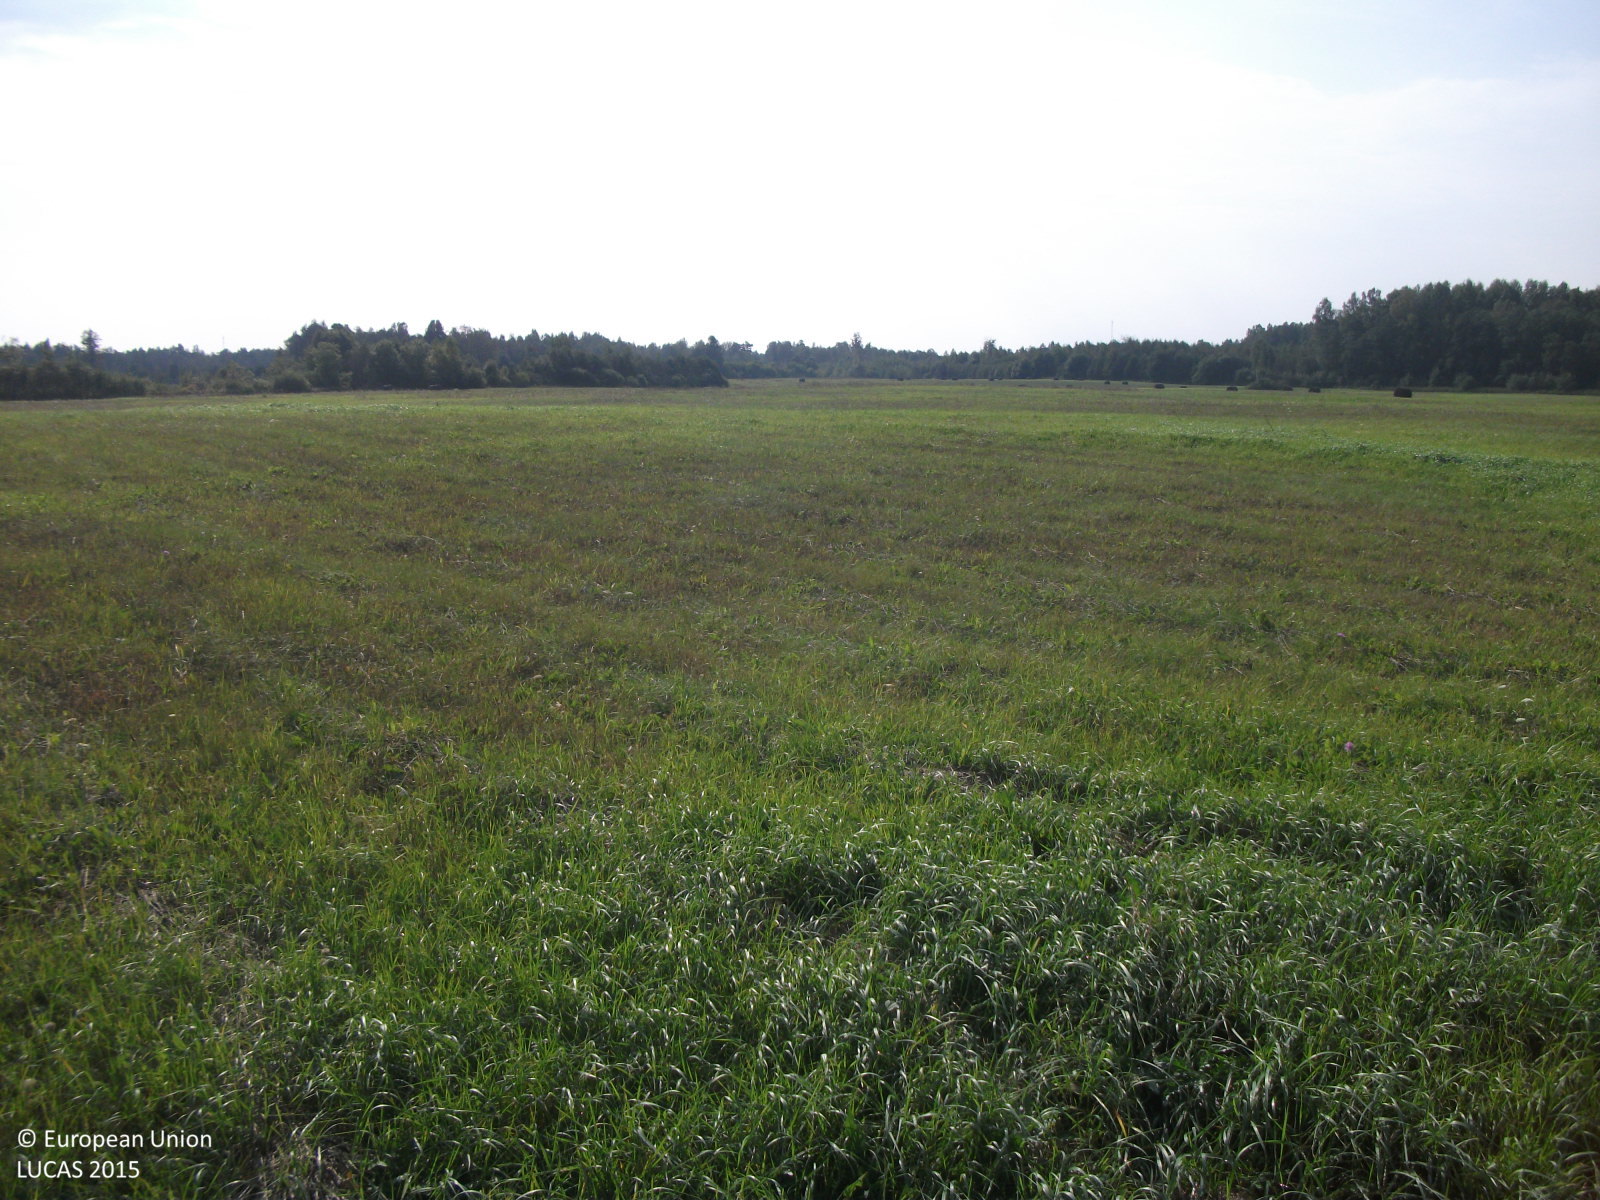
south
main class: Grassland
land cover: Grassland without tree/shrub cover
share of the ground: > 75 %
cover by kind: herbaceous plants 100 %
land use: Agriculture (excluding fallow land and kitchen gardens)
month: September
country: LV
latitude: 57.7893
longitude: 24.5391
